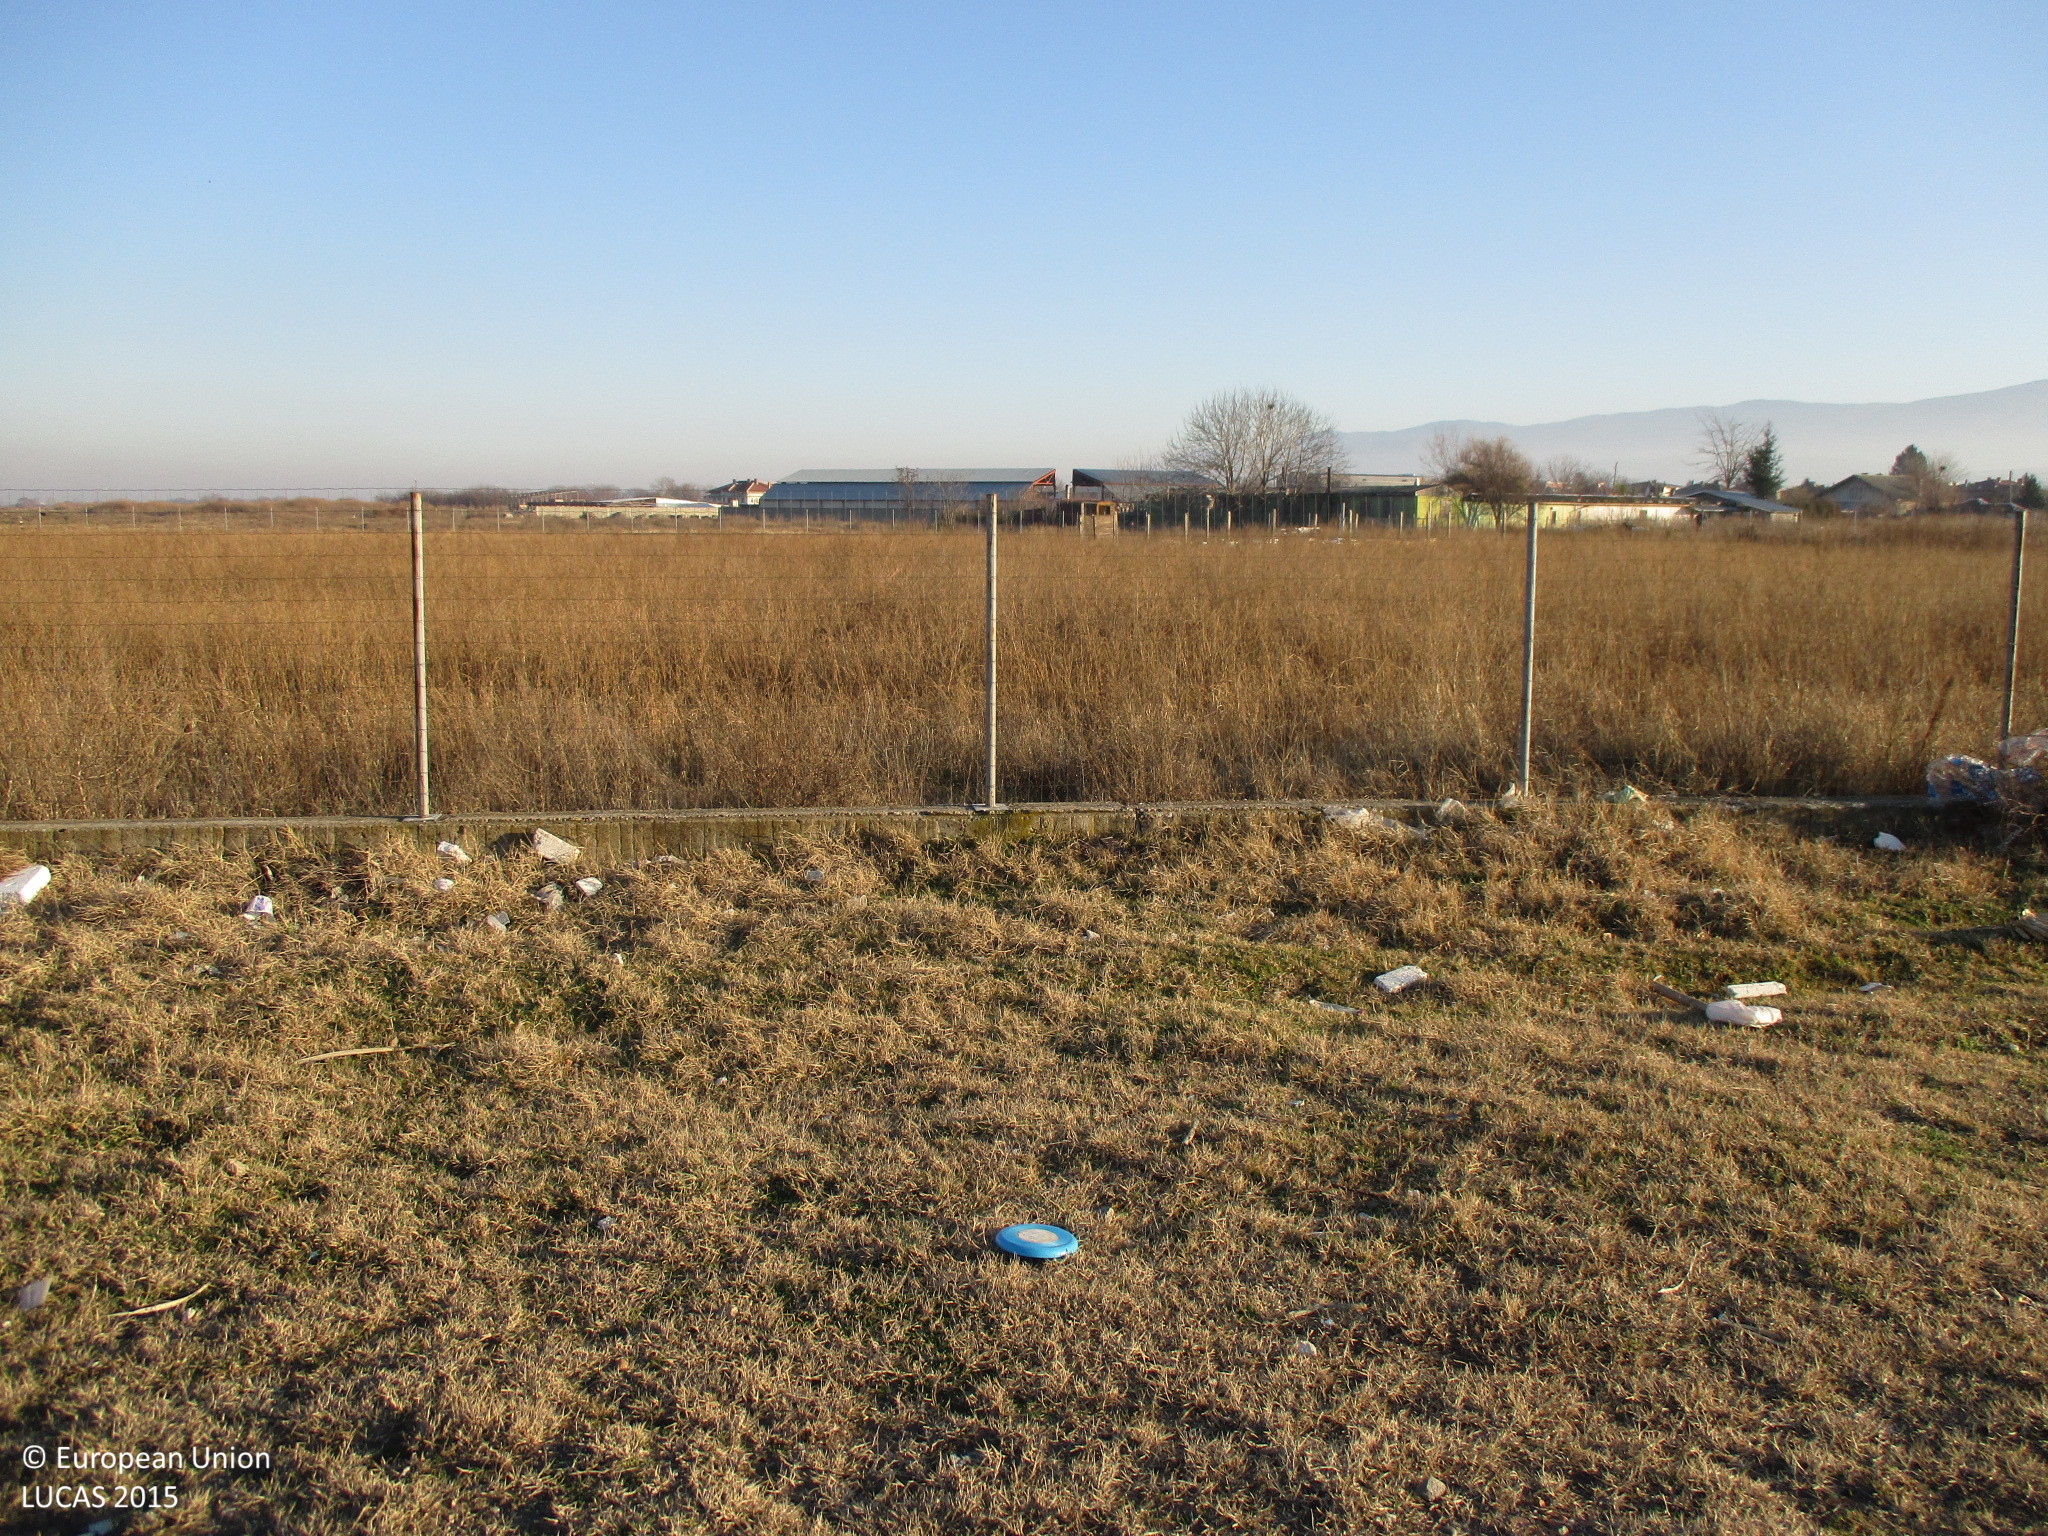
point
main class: Grassland
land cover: Grassland without tree/shrub cover
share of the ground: > 75 %
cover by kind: herbaceous plants 100 %
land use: Agriculture (excluding fallow land and kitchen gardens)
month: December
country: BG
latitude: 42.1387
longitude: 24.6040
